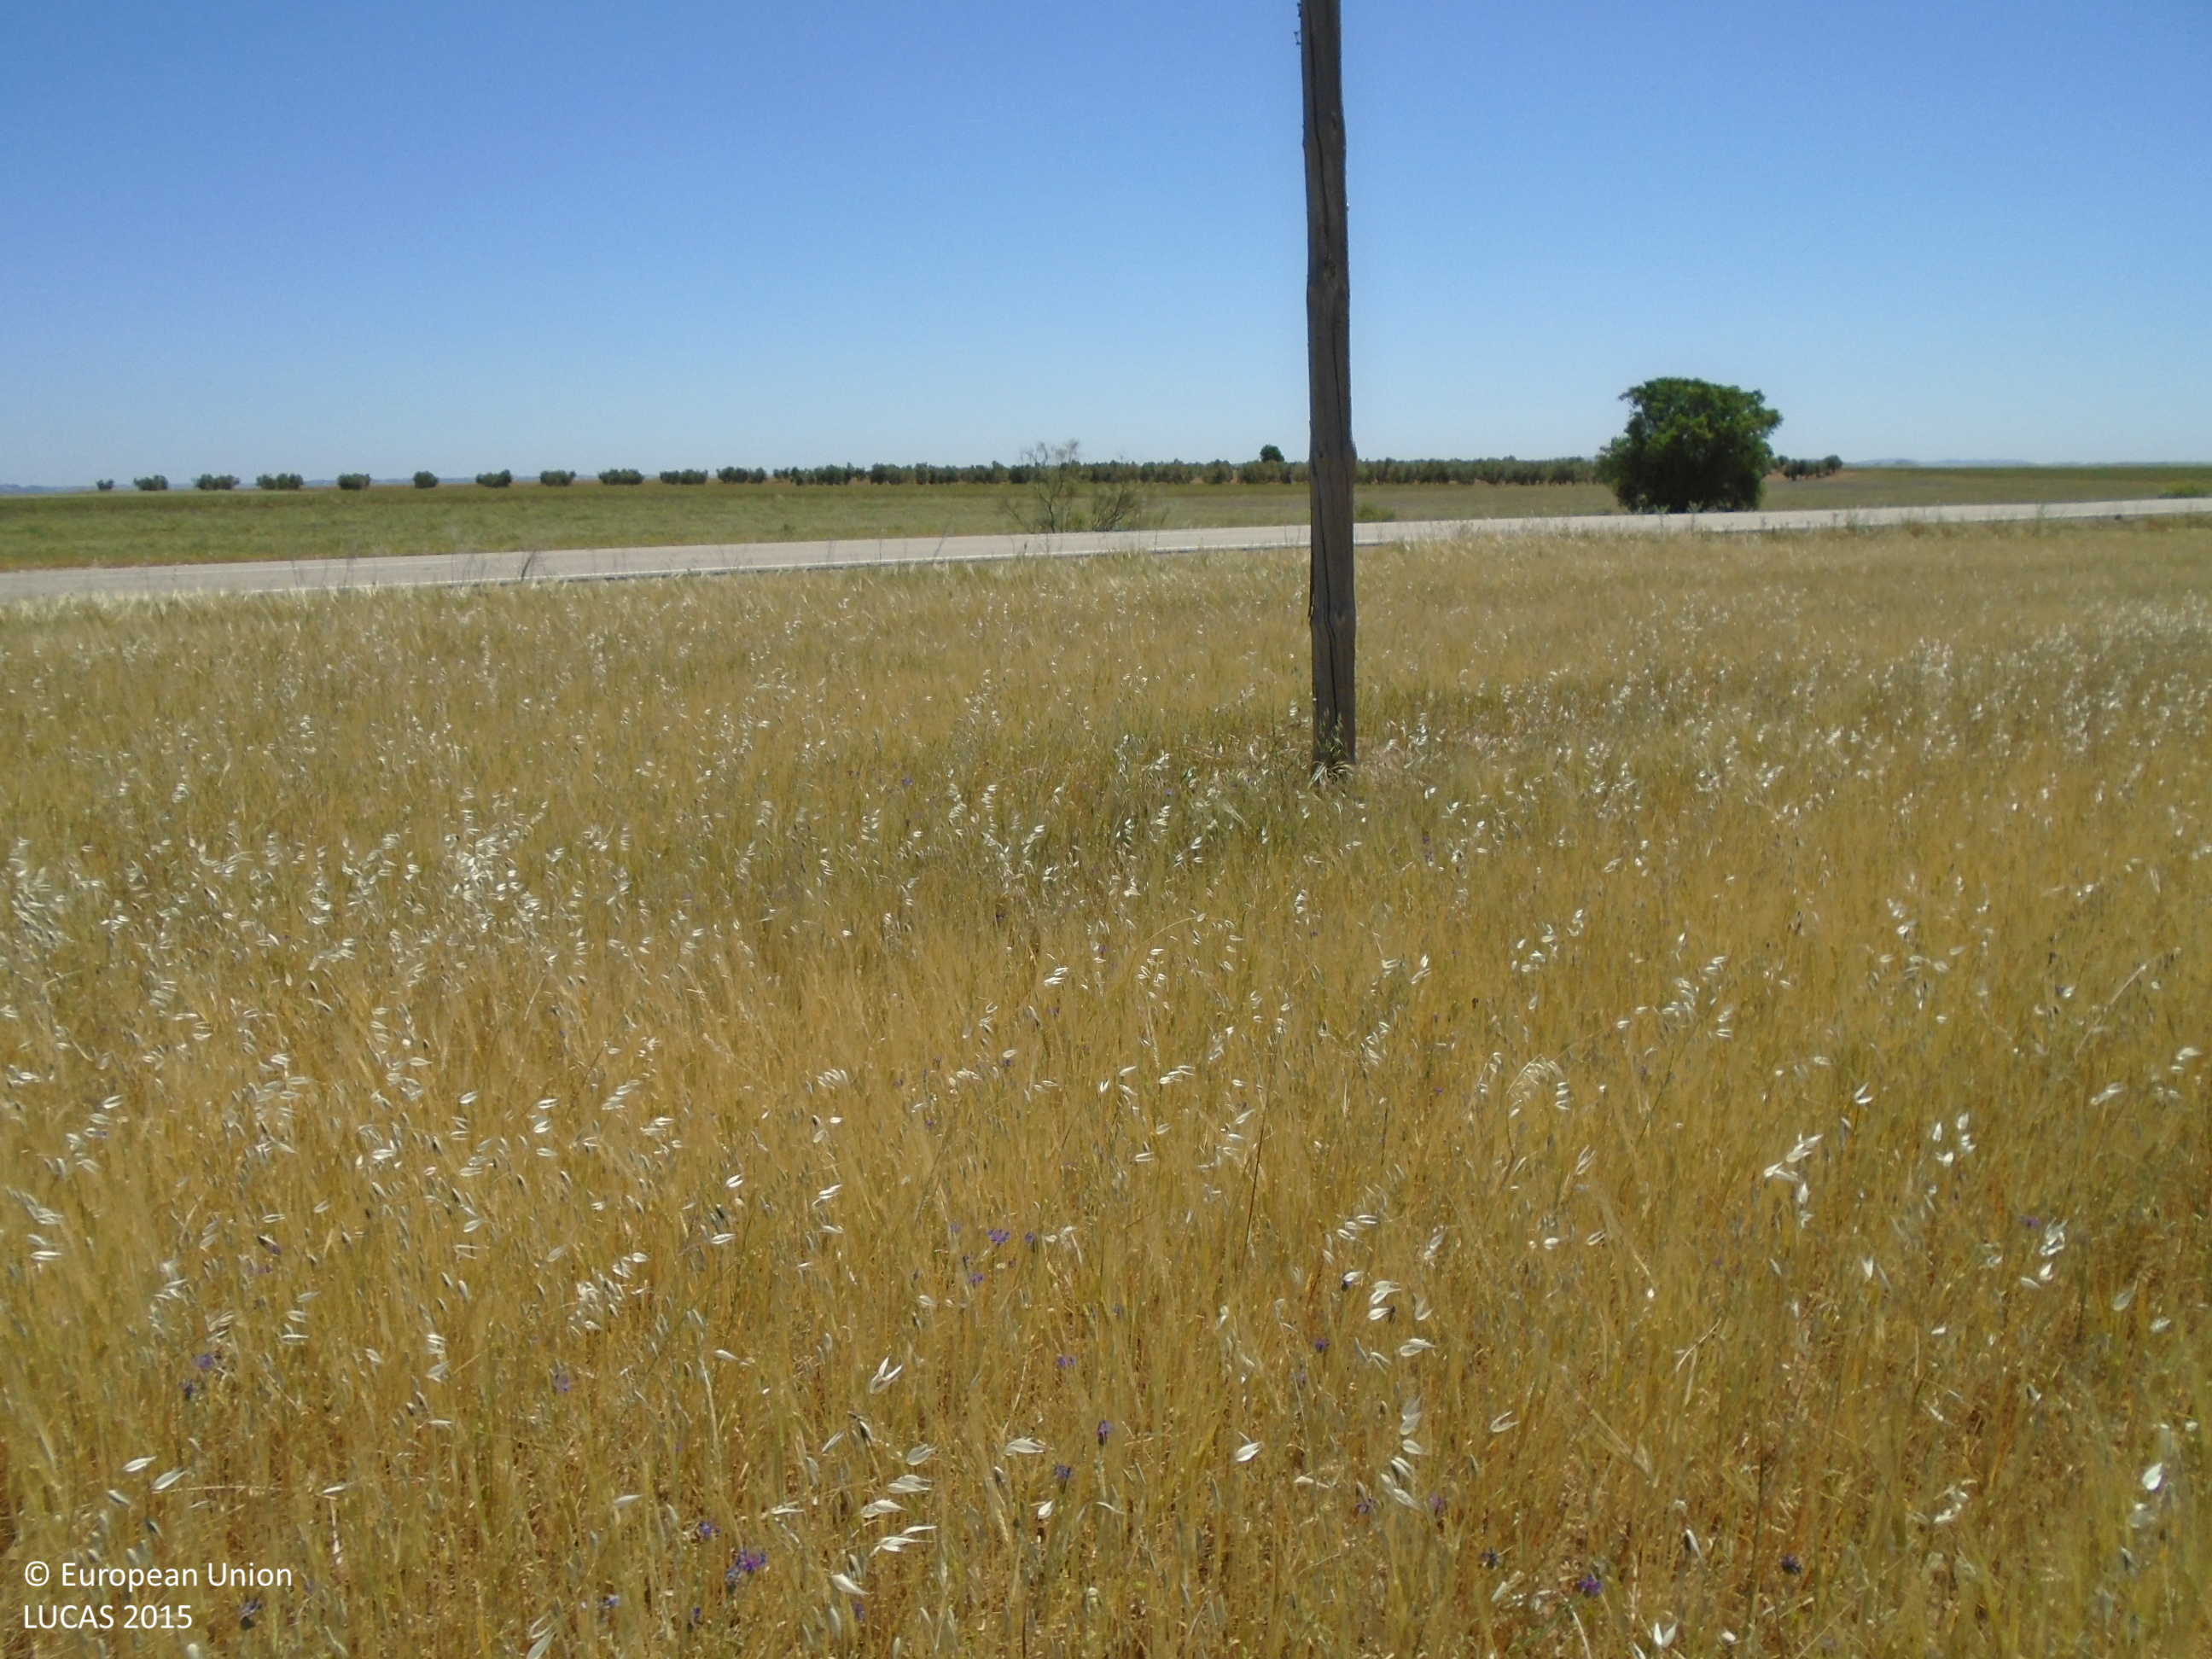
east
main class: Cropland
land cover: Barley
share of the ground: > 75 %
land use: Agriculture (excluding fallow land and kitchen gardens)
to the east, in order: Barley; Electric lines; Barley; Electric lines; Barley; Grass margins; Ditches and canals; Paved roads, cycling and walking lanes; Ditches and canals; Shrubland without tree cover; Tracks; Grass margins; Dry pulses; Grass margins; Common wheat
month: May
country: ES
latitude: 39.7630
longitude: -3.6742
